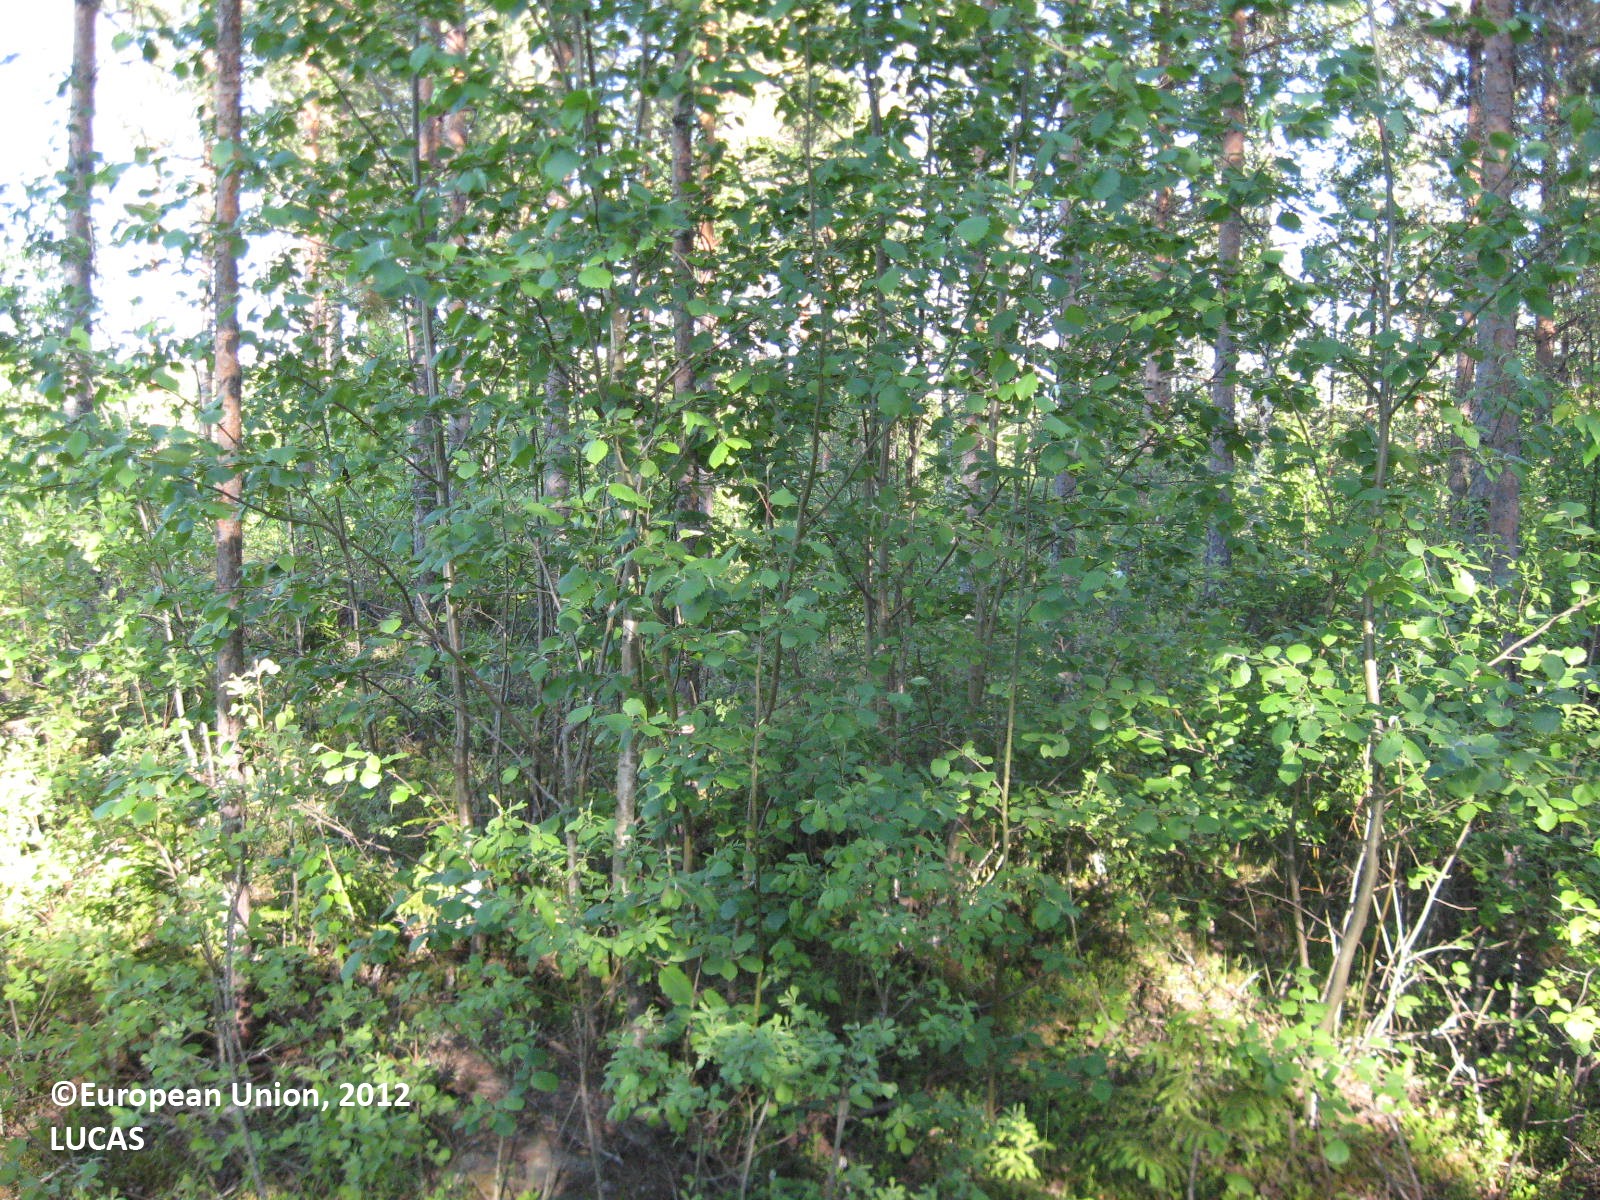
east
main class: Woodland
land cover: Pine dominated coniferous woodland
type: boreal forest
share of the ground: > 75 %
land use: Forestry
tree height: > 5 m
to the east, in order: Pine dominated coniferous woodland; Broadleaved woodland; Ditches and canals; Broadleaved woodland; Ditches and canals; Broadleaved woodland; Pine dominated coniferous woodland
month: June
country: FI
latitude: 62.8229
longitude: 21.5614
